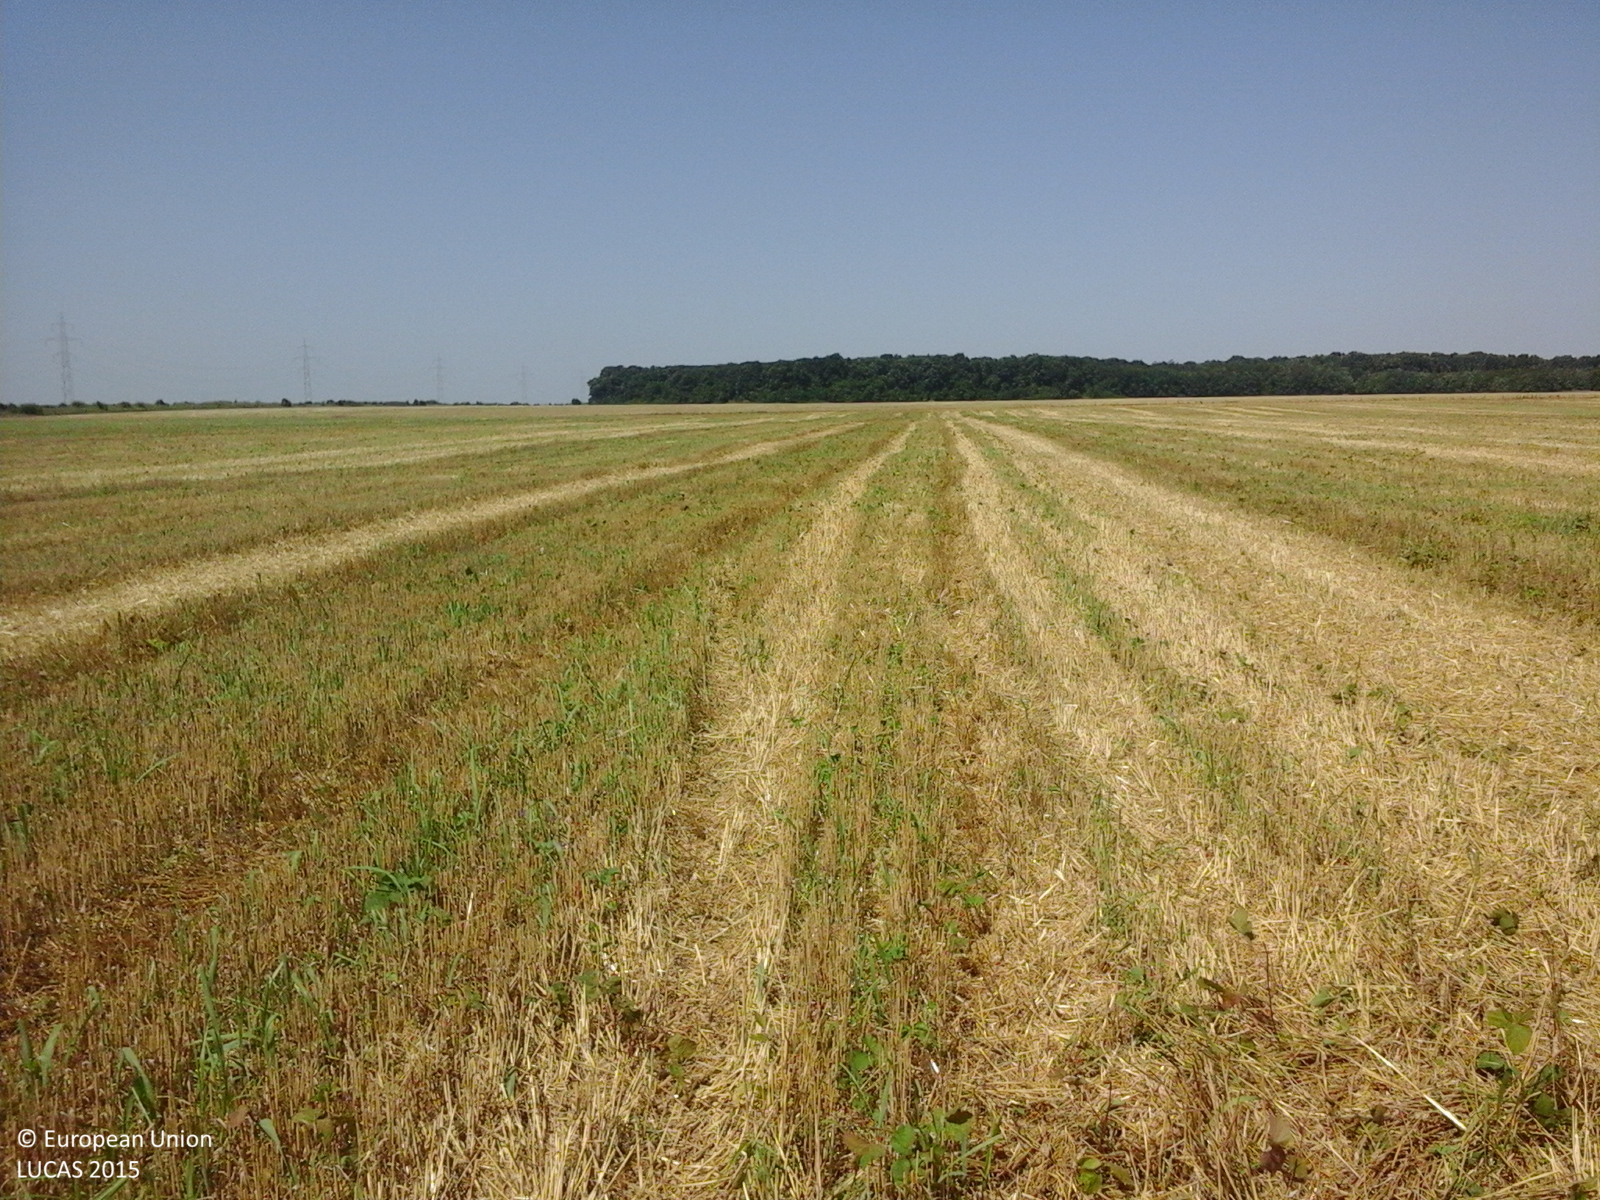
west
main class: Cropland
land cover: Common wheat
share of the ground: < 10 %
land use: Agriculture (excluding fallow land and kitchen gardens)
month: July
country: RO
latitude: 44.4051
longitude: 26.4496
